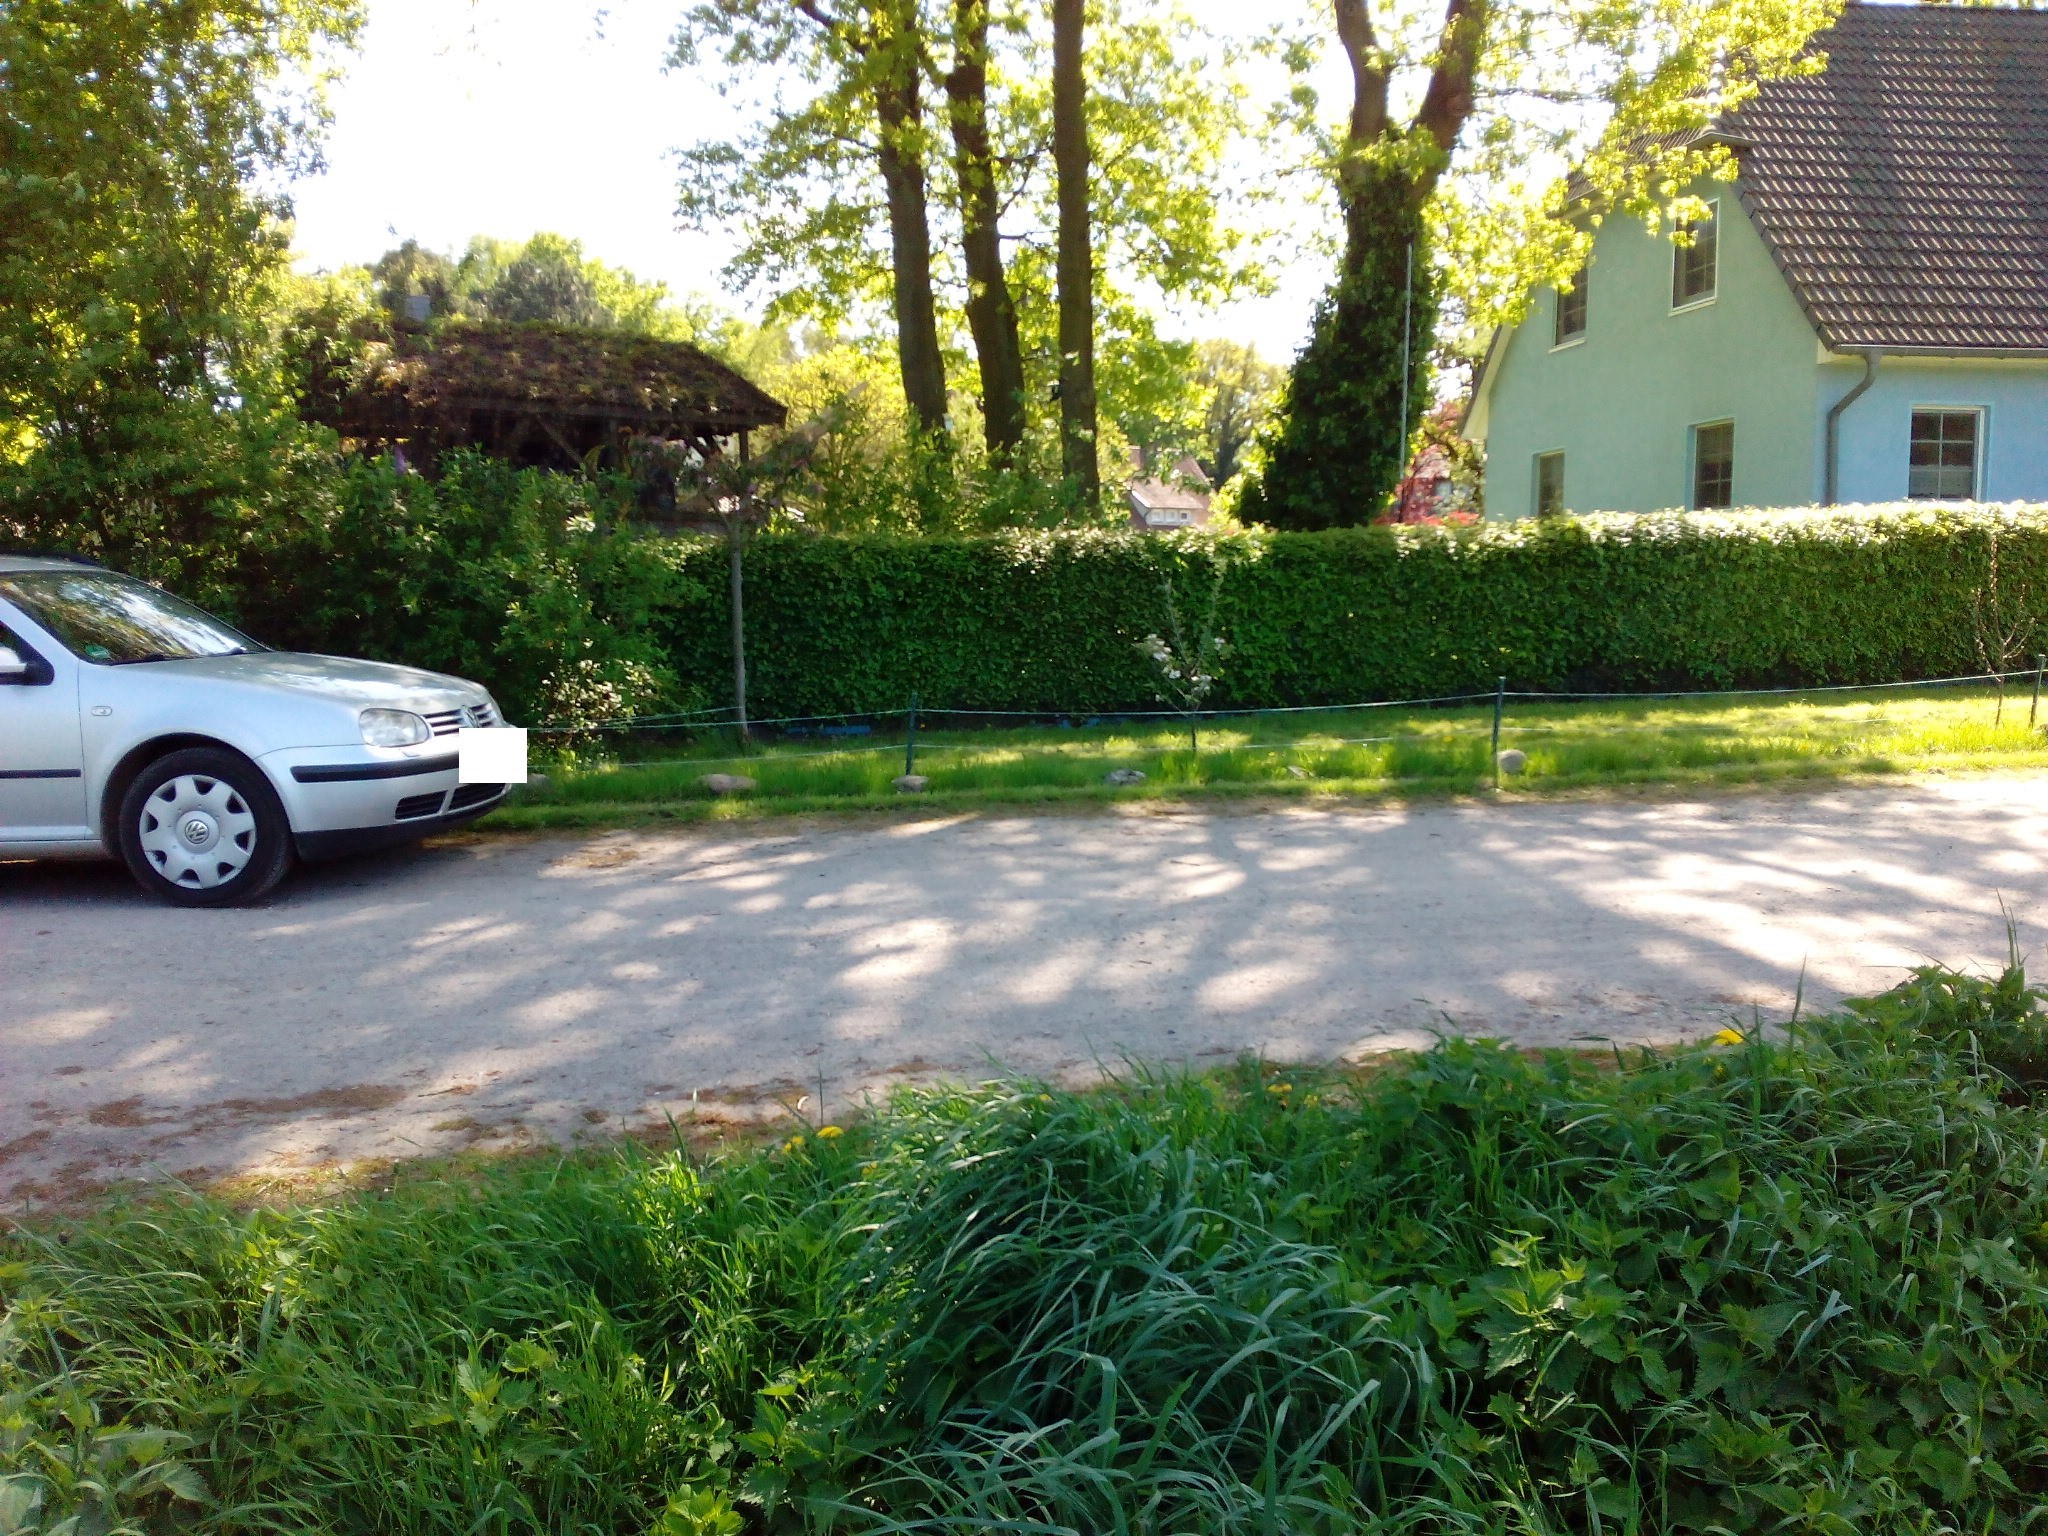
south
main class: Grassland
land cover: Grassland without tree/shrub cover
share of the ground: > 75 %
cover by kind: herbaceous plants 100 %
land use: Agriculture (excluding fallow land and kitchen gardens)
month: May
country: DE
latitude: 52.4673
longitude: 9.8970
